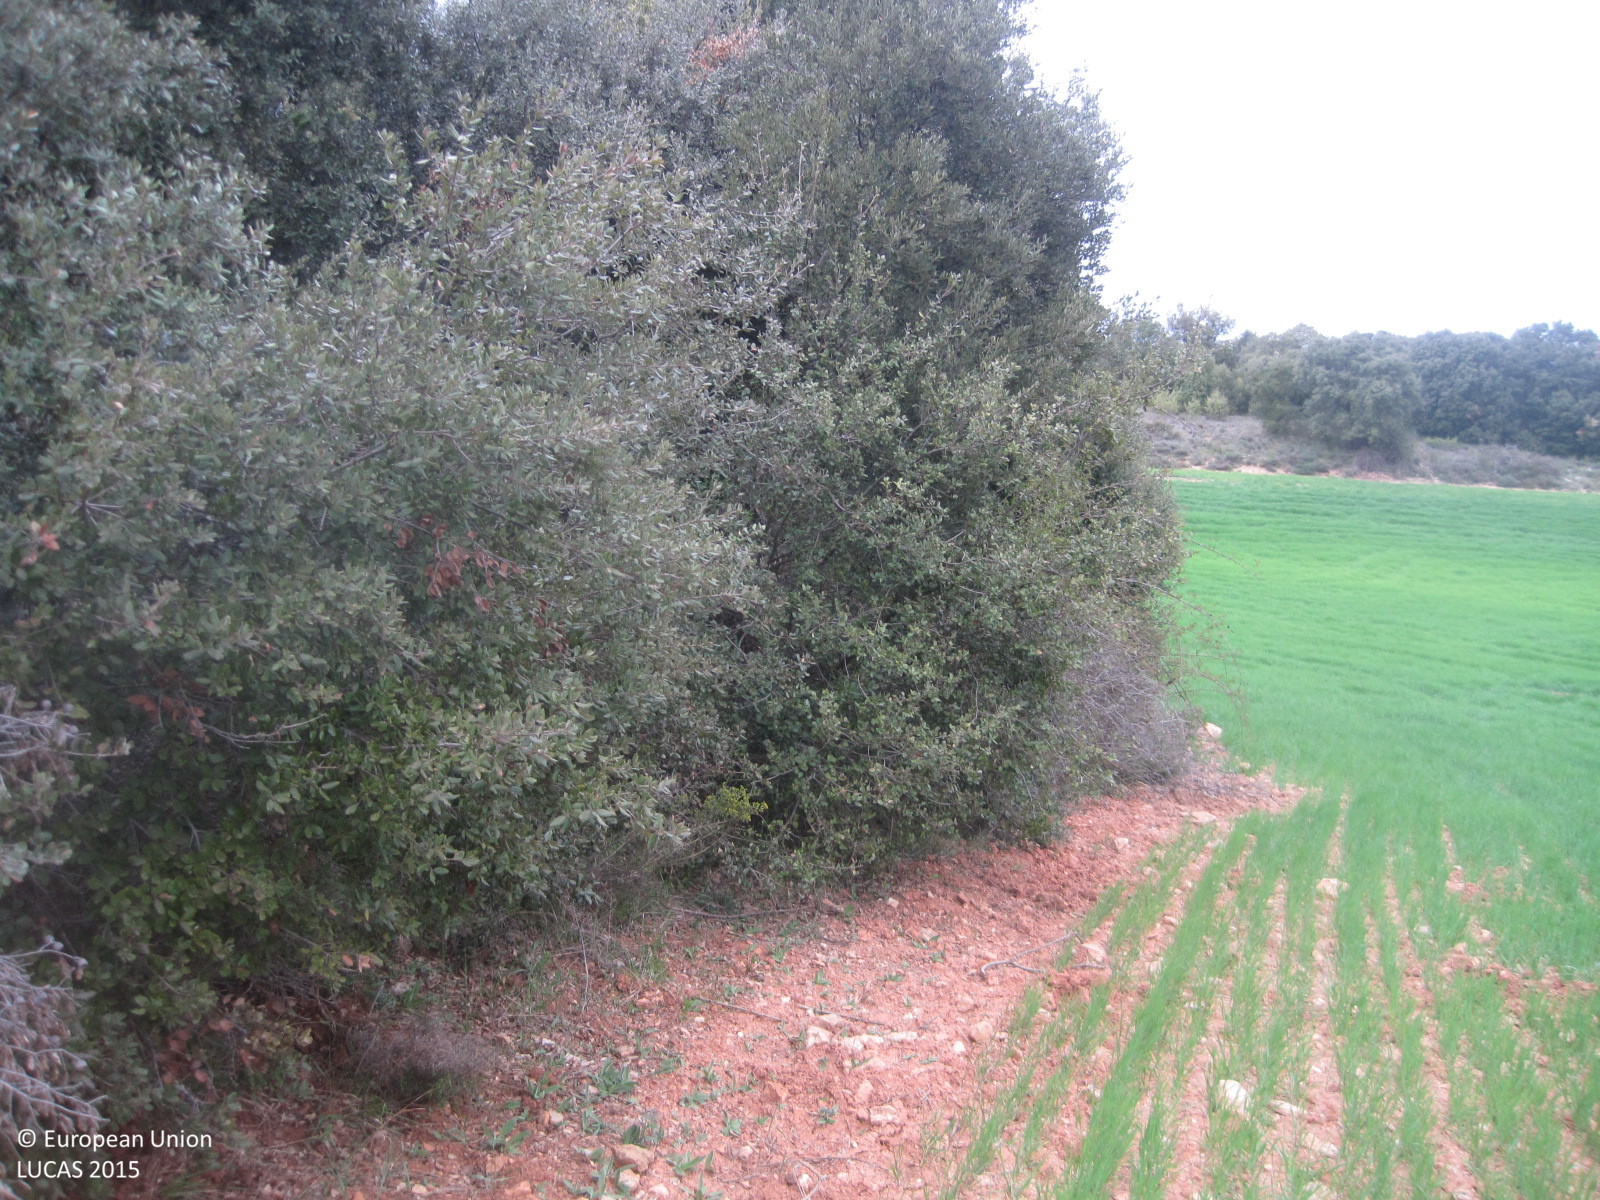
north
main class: Cropland
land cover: Barley
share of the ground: > 75 %
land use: Agriculture (excluding fallow land and kitchen gardens)
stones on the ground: > 50 %
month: April
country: ES
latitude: 42.6428
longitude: -2.2034
